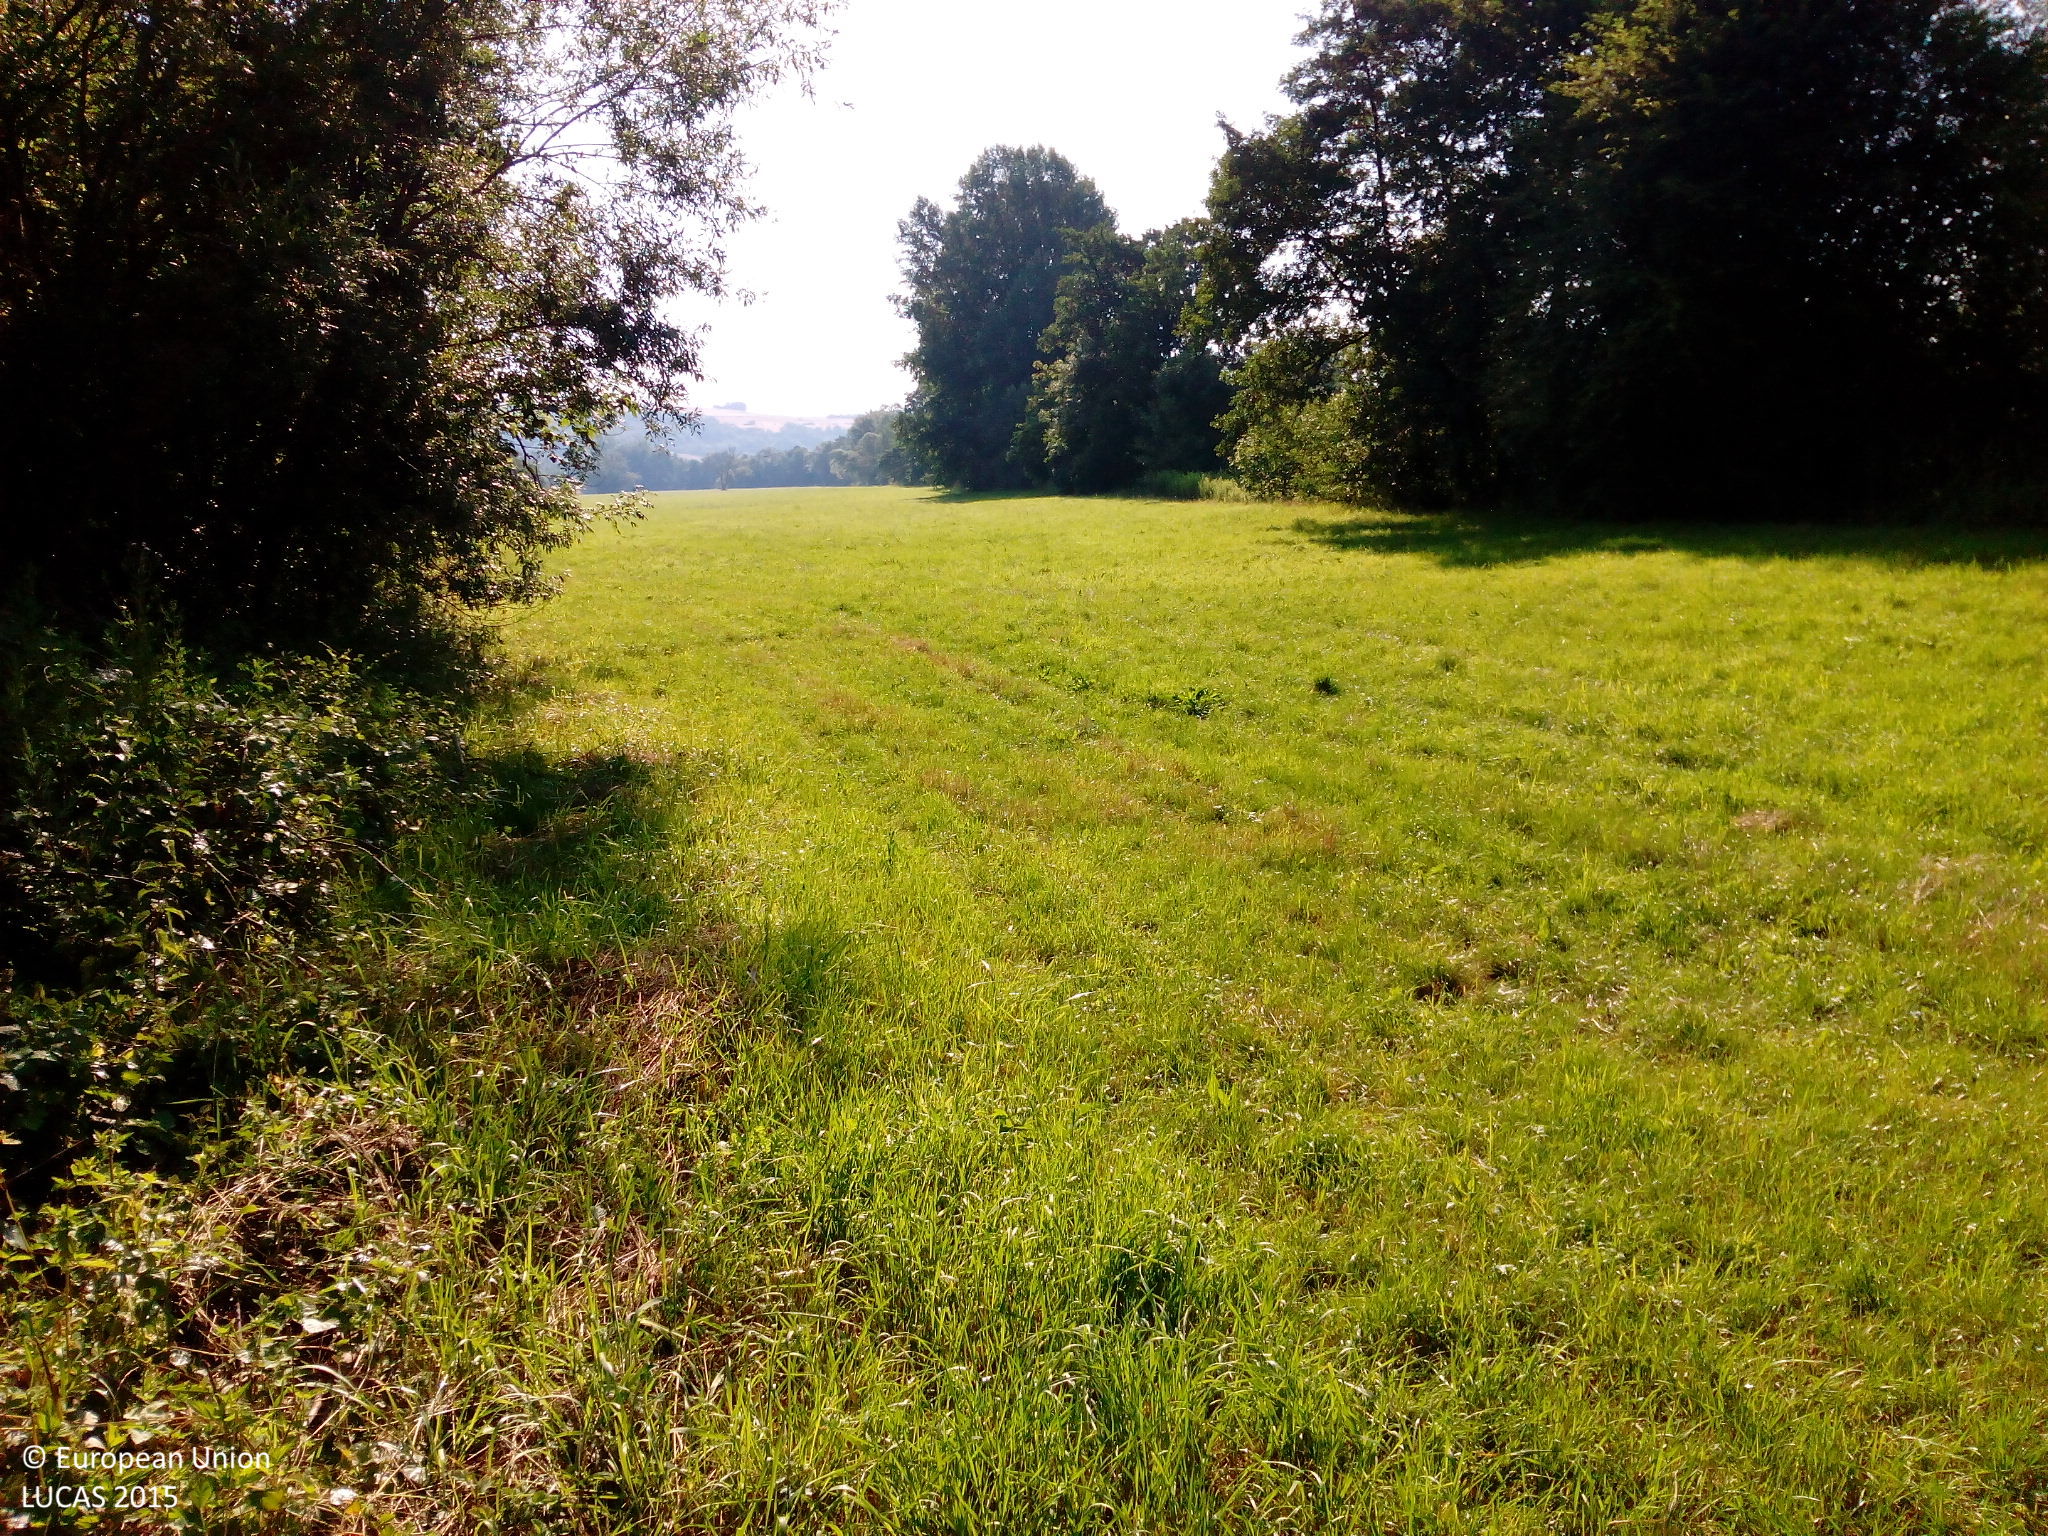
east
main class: Grassland
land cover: Grassland without tree/shrub cover
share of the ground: > 75 %
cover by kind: herbaceous plants 100 %
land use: Agriculture (excluding fallow land and kitchen gardens)
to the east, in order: Grassland without tree/shrub cover; Broadleaved woodland; Inland fresh running water
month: July
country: DE
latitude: 49.1398
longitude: 7.1082
